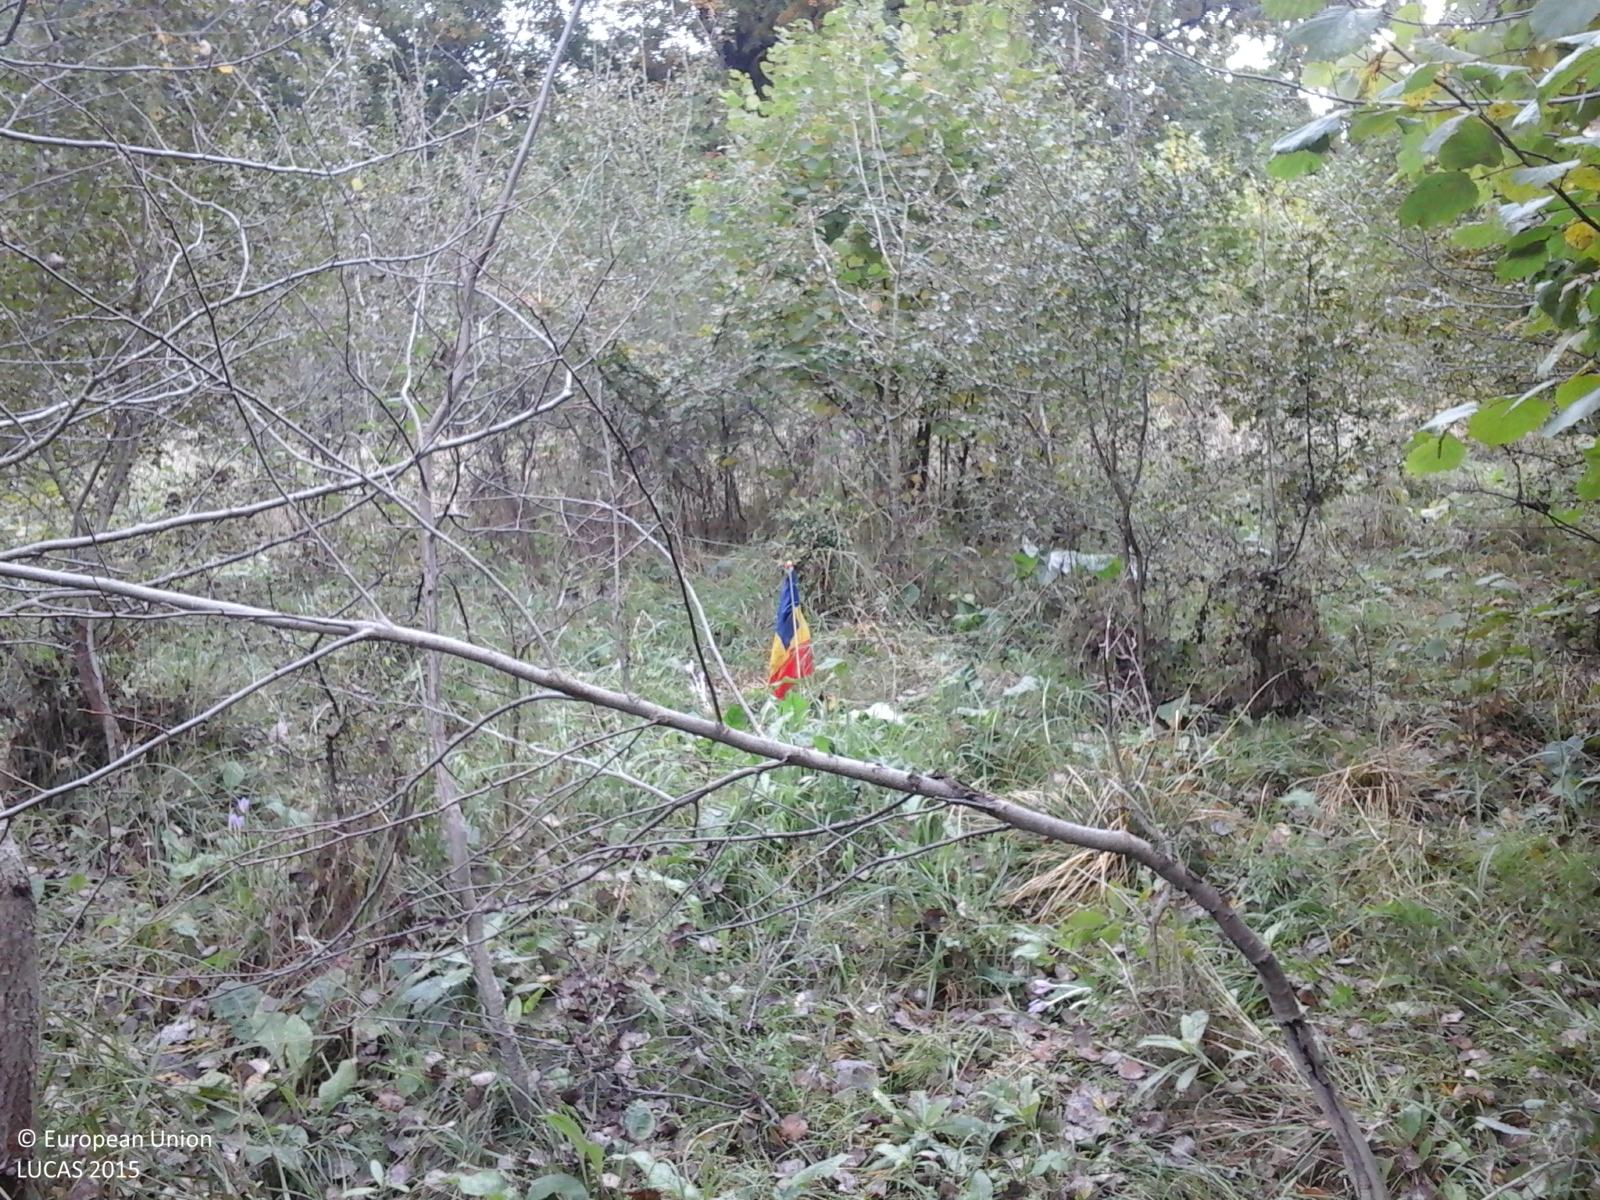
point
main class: Shrubland
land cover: Shrubland with sparse tree cover
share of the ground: > 75 %
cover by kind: shrubs 85 %, herbaceous plants 10 %, broadleaved forest trees 5 %
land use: Fallow land
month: October
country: RO
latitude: 46.2917
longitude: 24.8784
